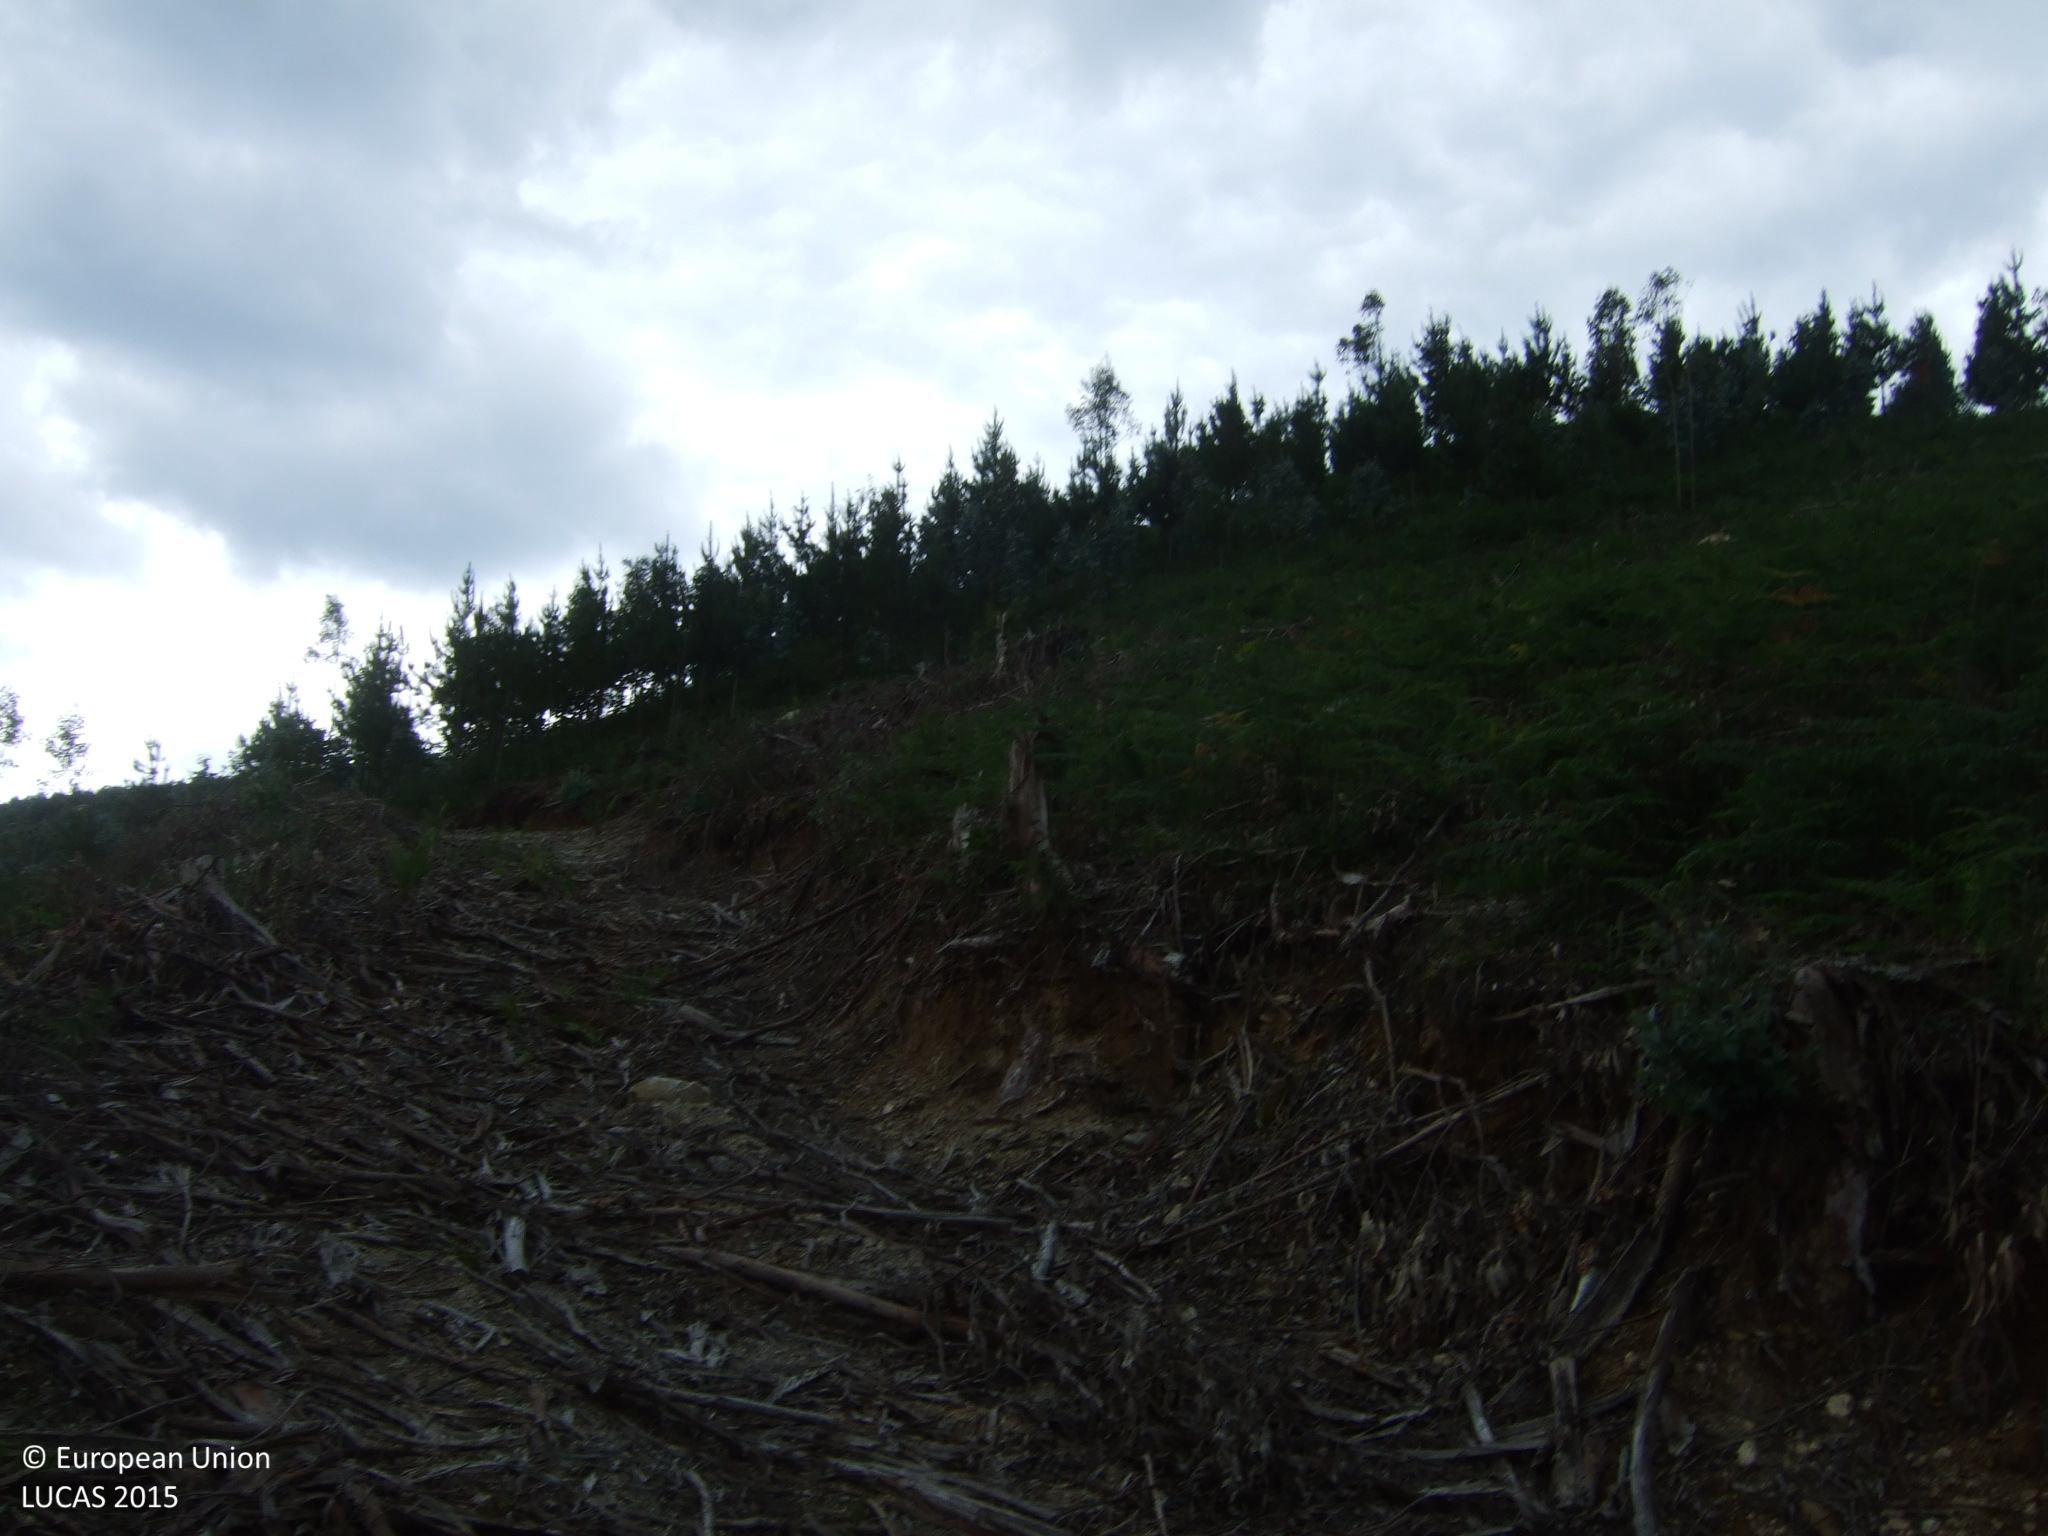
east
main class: Grassland
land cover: Spontaneously vegetated surfaces
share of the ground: 50 - 75 %
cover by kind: herbaceous plants 50 %, unconsolidated bare surface 50 %
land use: Forestry
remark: Clear cut
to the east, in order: Spontaneously vegetated surfaces; Broadleaved woodland
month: June
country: ES
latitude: 43.4973
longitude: -7.4813
